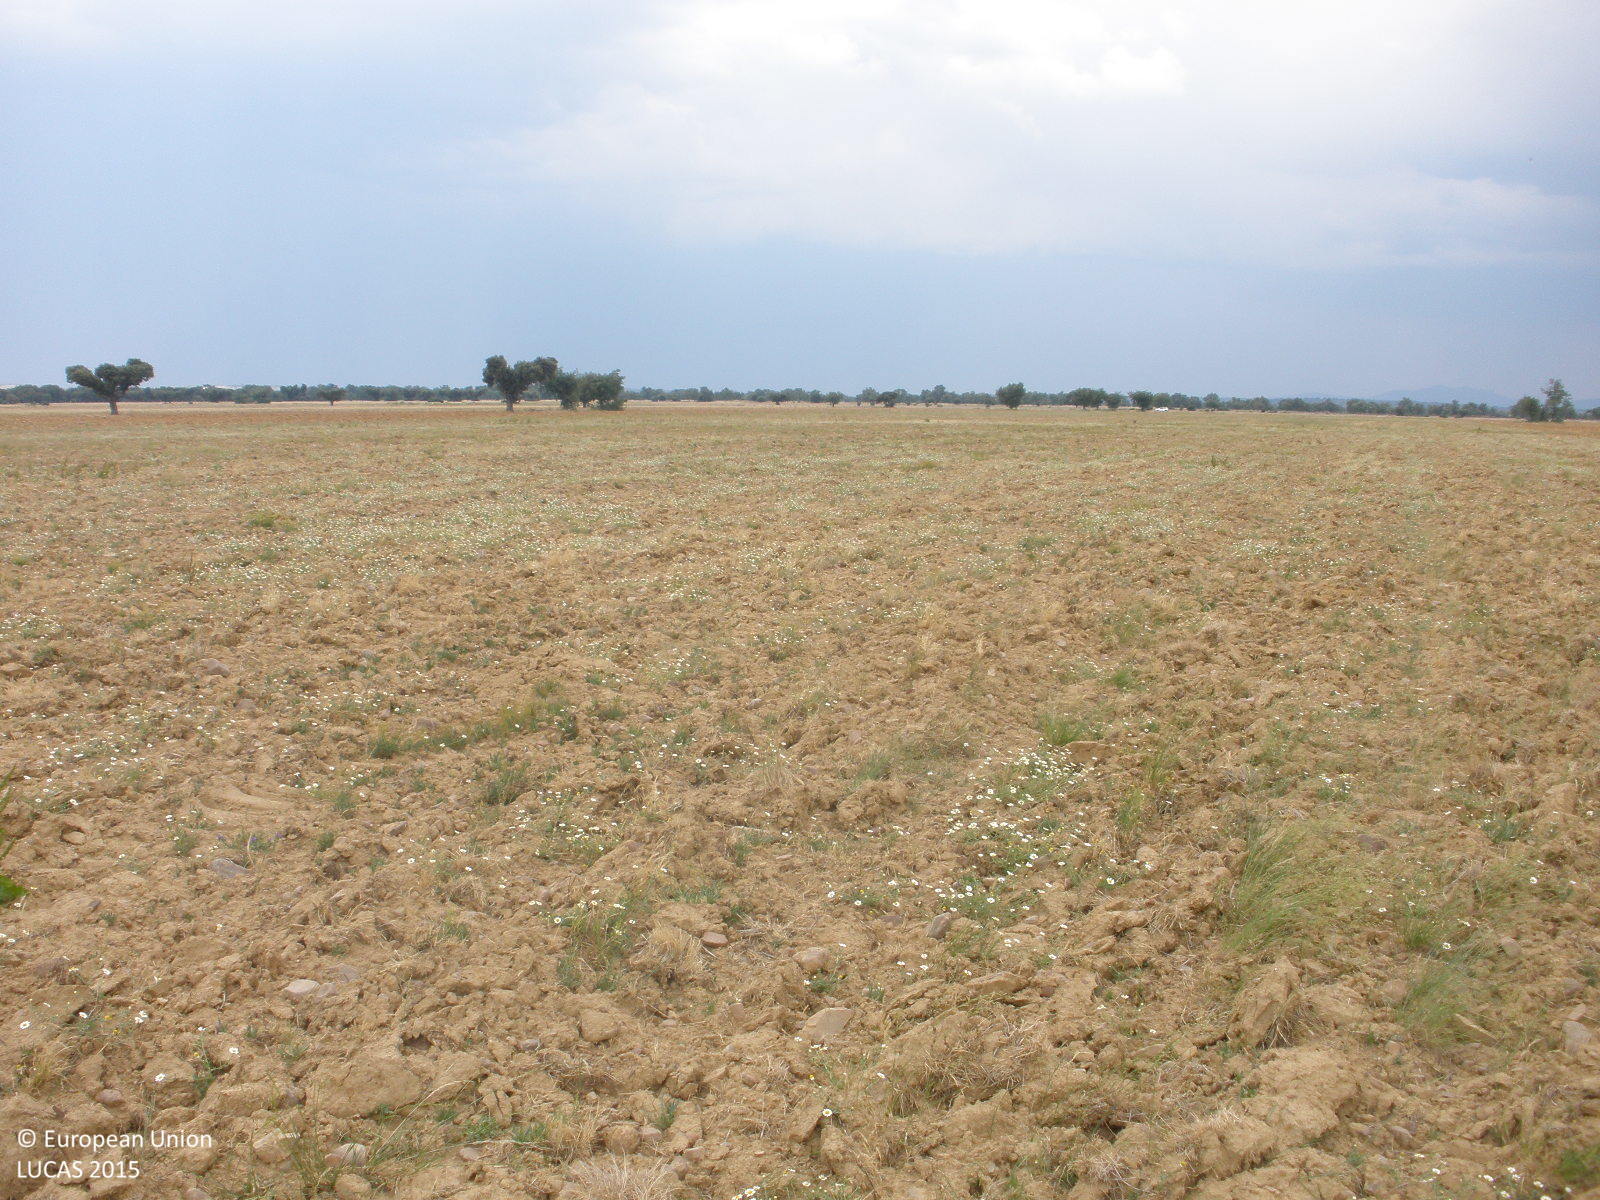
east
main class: Grassland
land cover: Spontaneously vegetated surfaces
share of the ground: 25 - 50 %
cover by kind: unconsolidated bare surface 60 %, herbaceous plants 40 %
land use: Fallow land
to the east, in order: Spontaneously vegetated surfaces; Other bare soil
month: June
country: ES
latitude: 40.7371
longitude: -6.3948
